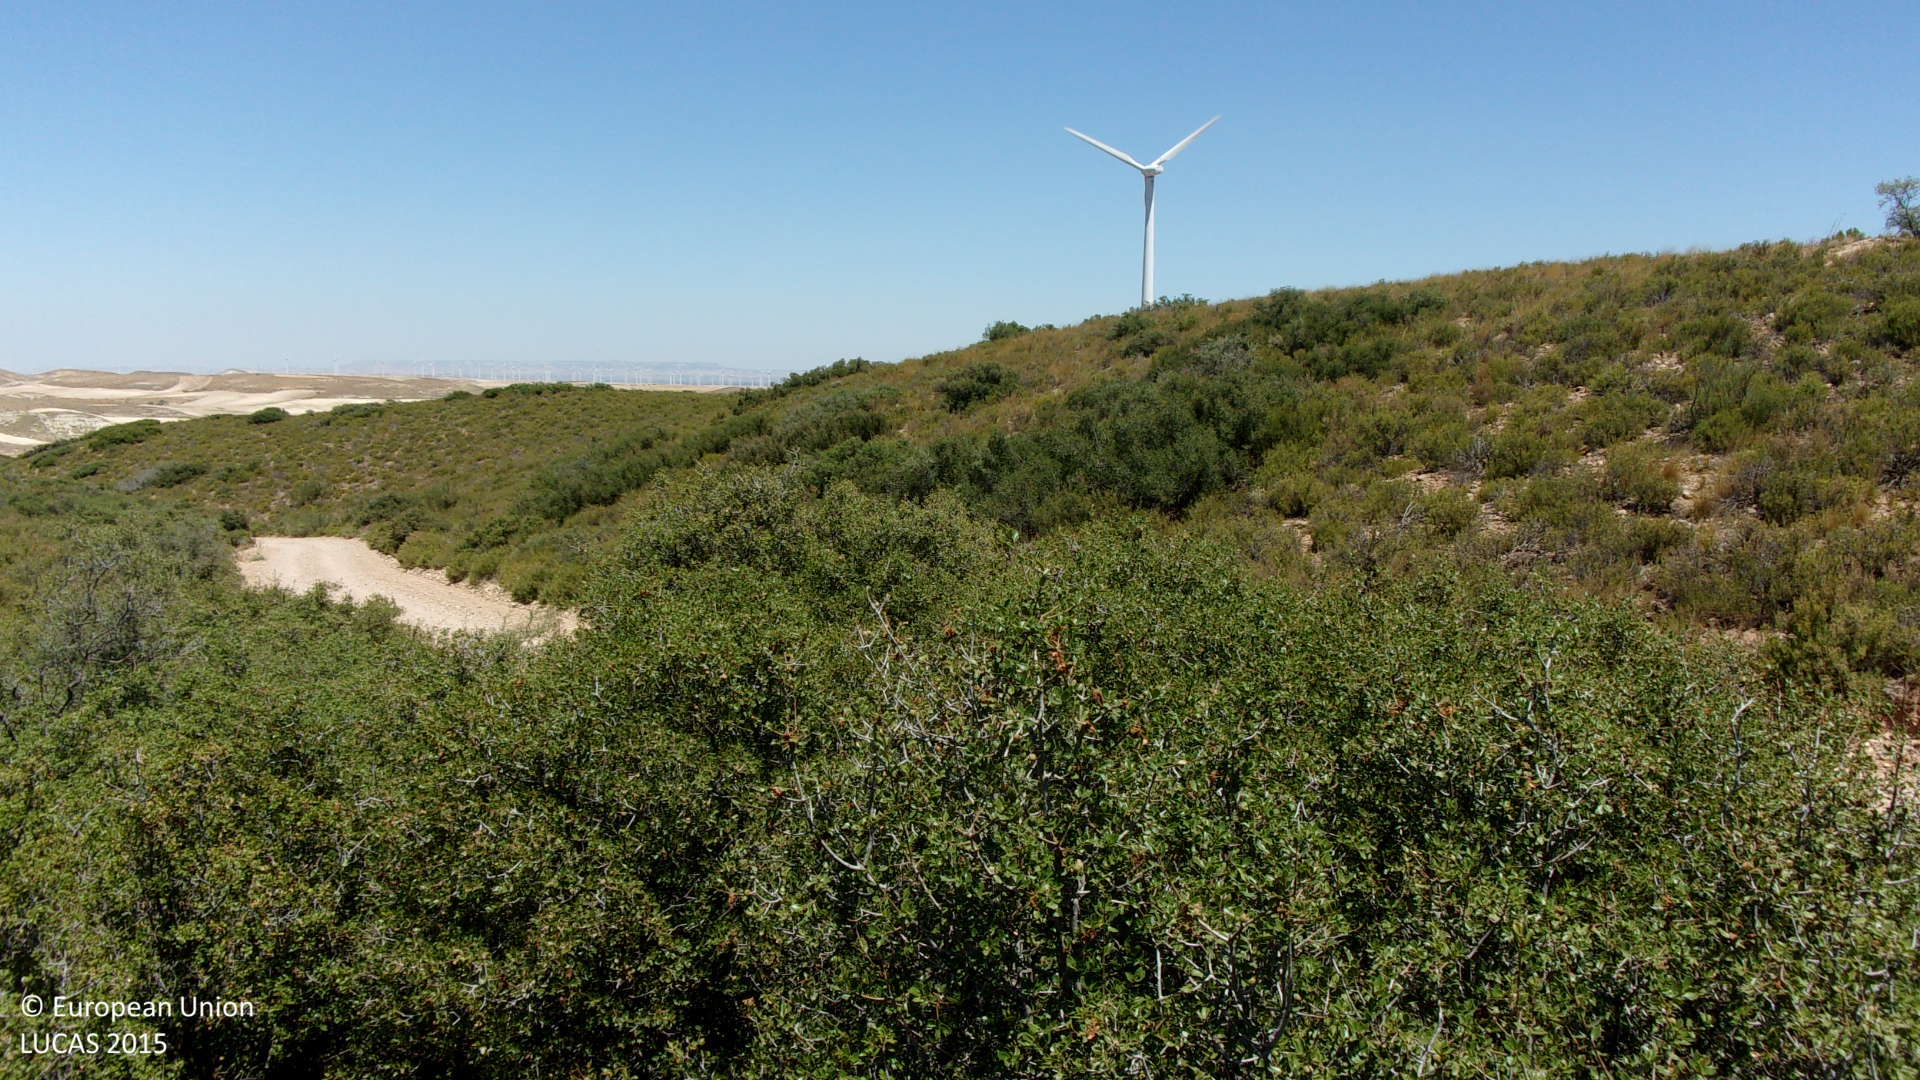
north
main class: Shrubland
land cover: Shrubland without tree cover
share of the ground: > 75 %
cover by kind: shrubs 85 %, consolidated bare surface 10 %, herbaceous plants 5 %
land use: Semi-natural and natural areas not in use
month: July
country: ES
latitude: 41.7140
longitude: -1.2633
